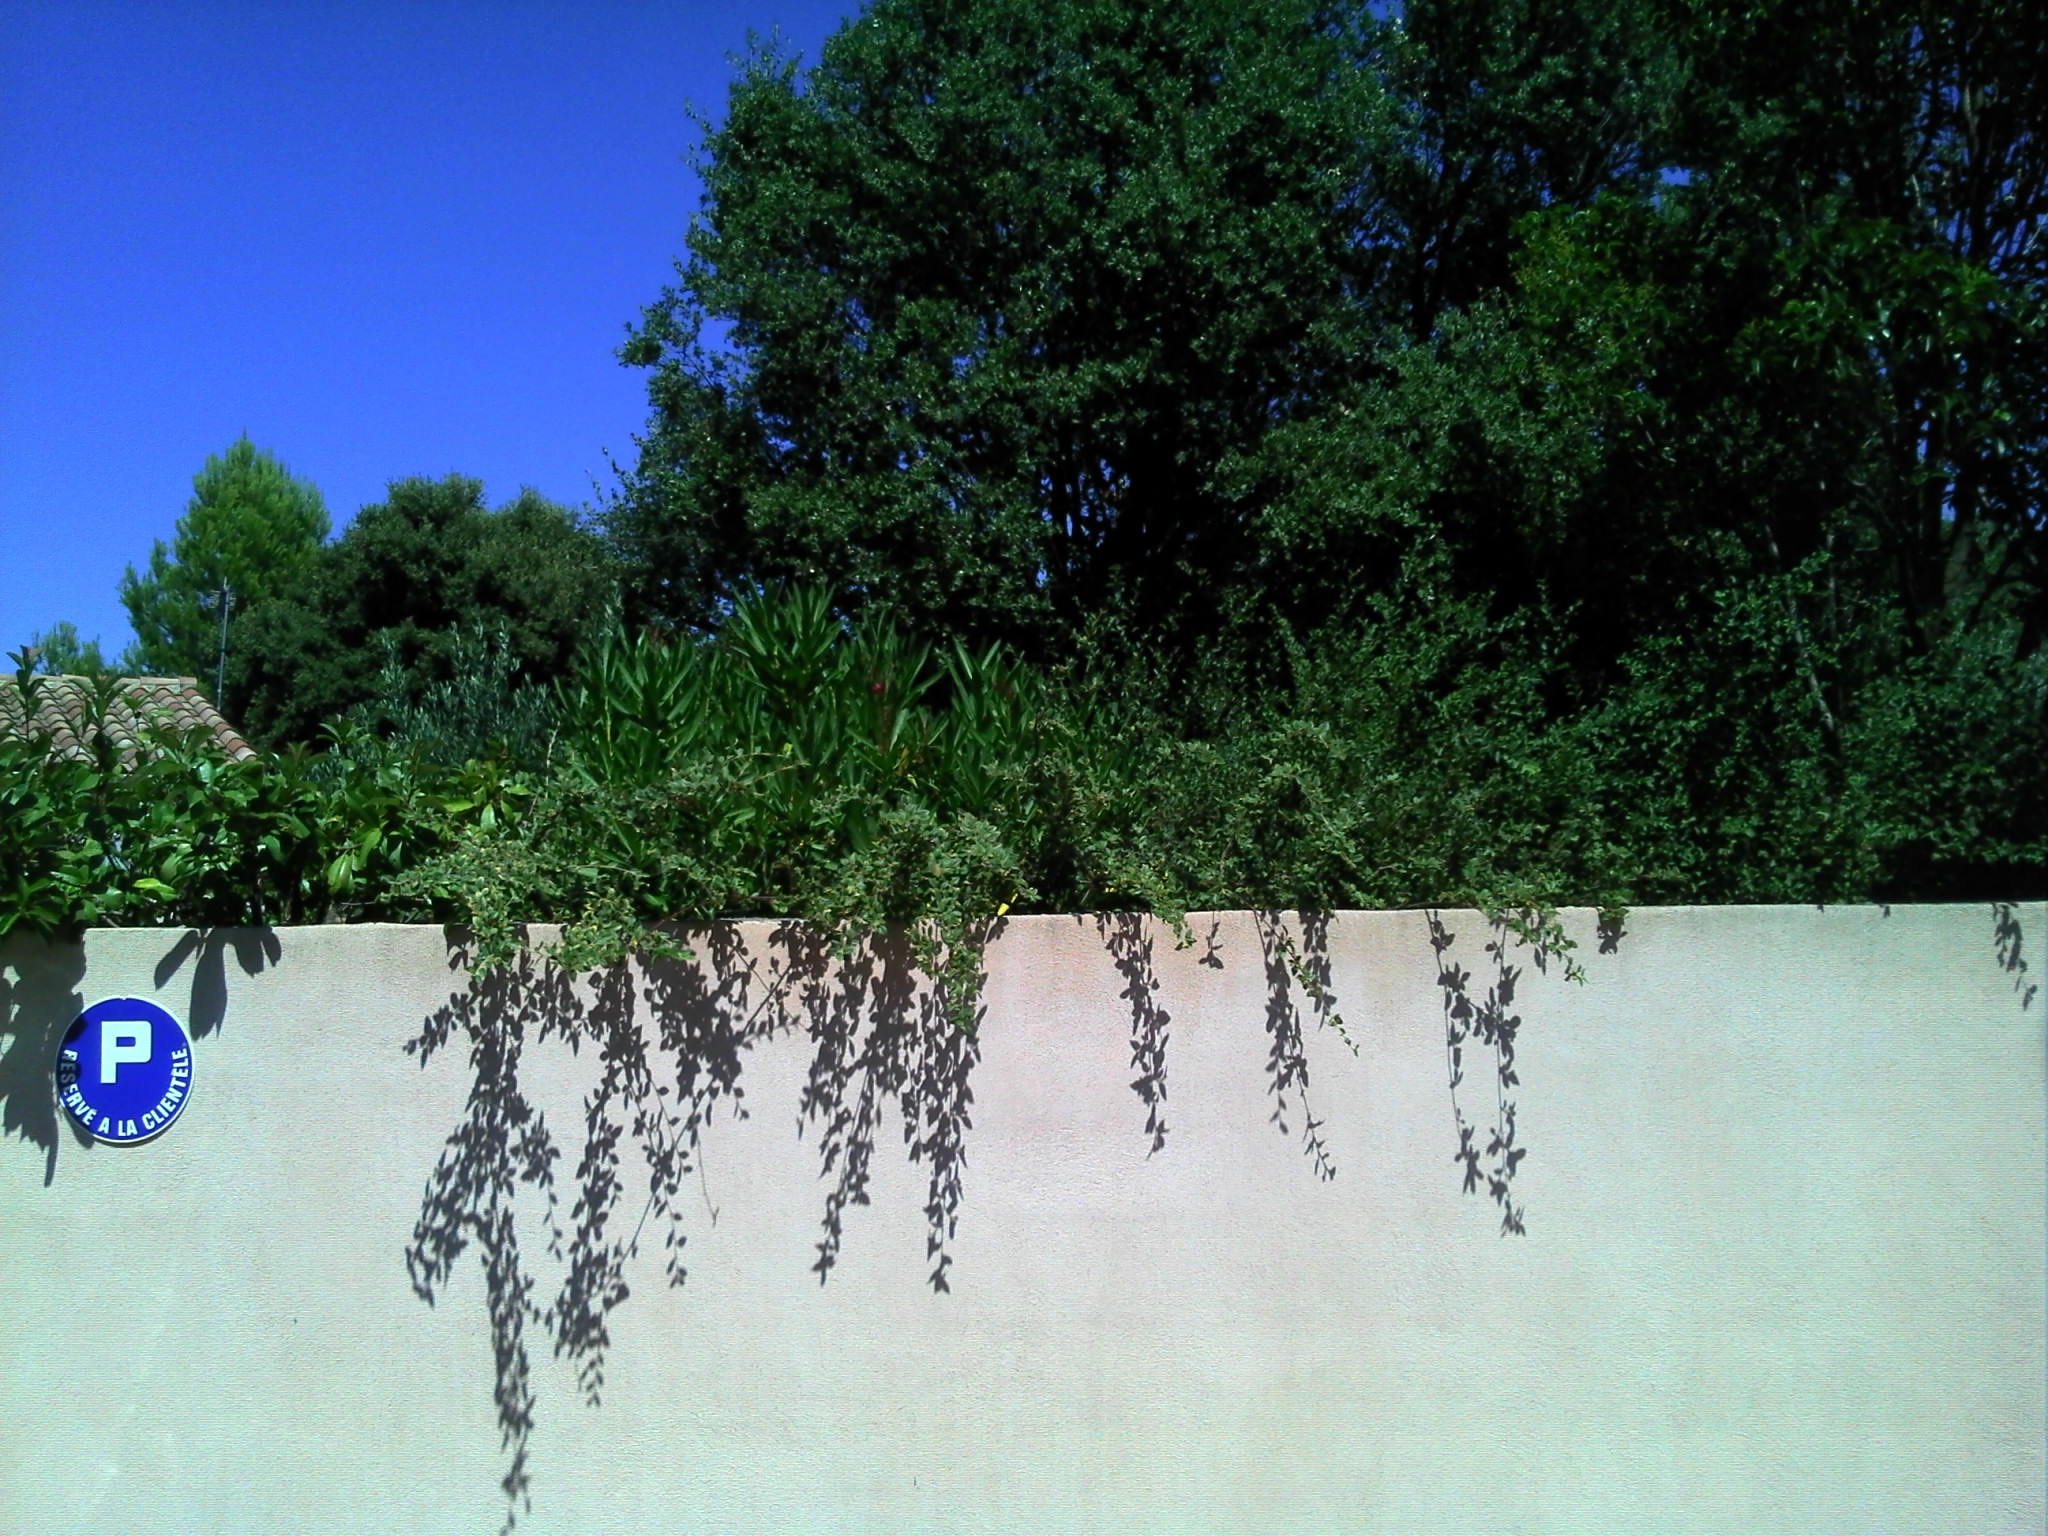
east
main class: Woodland
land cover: Broadleaved woodland
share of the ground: 50 - 75 %
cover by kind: broadleaved forest trees 70 %, consolidated bare surface 20 %, herbaceous plants 10 %
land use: Residential
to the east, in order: Broadleaved woodland; Artificial constructions in urban areas; Spontaneously vegetated surfaces; Other bare soil; Artificial constructions in urban areas
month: August
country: FR
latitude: 43.9652
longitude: 4.7613
